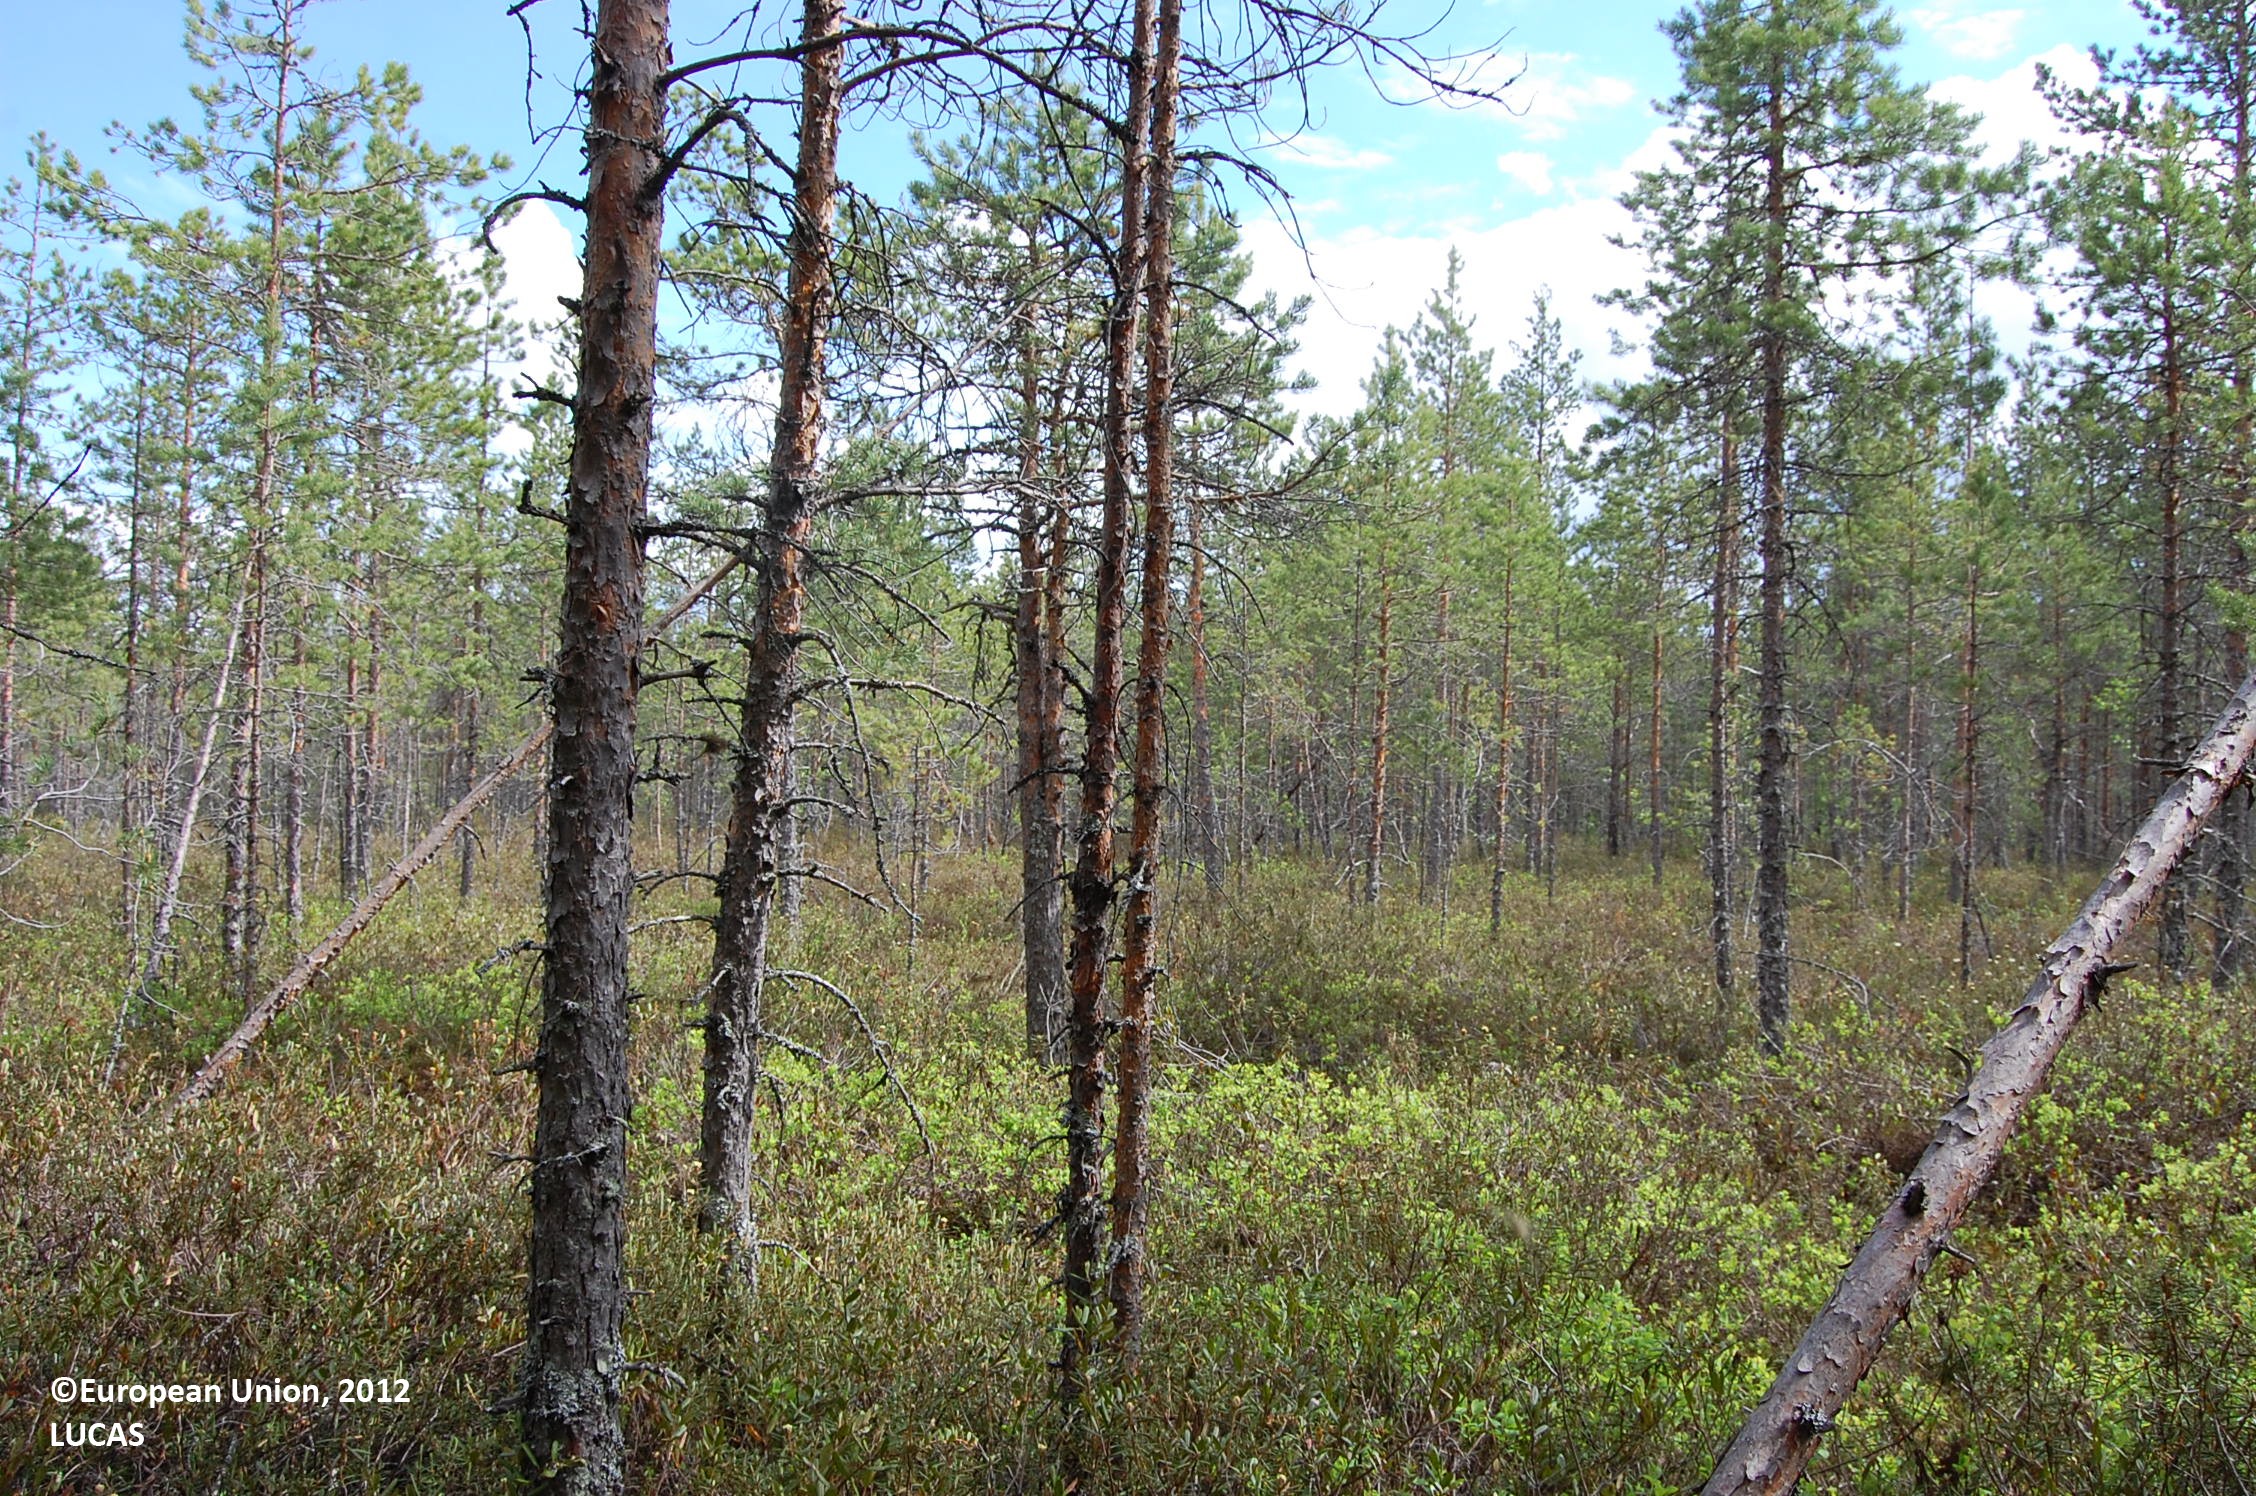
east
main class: Woodland
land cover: Pine dominated coniferous woodland
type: hemiboreal forest and nemoral coniferous forest and mixed broadleaved-coniferous forest
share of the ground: > 75 %
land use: Forestry
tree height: > 5 m
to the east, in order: Pine dominated coniferous woodland; Ditches and canals; Pine dominated coniferous woodland; Ditches and canals; Pine dominated coniferous woodland; Ditches and canals; Pine dominated coniferous woodland; Ditches and canals; Pine dominated coniferous woodland
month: June
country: FI
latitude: 64.1278
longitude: 26.2358
